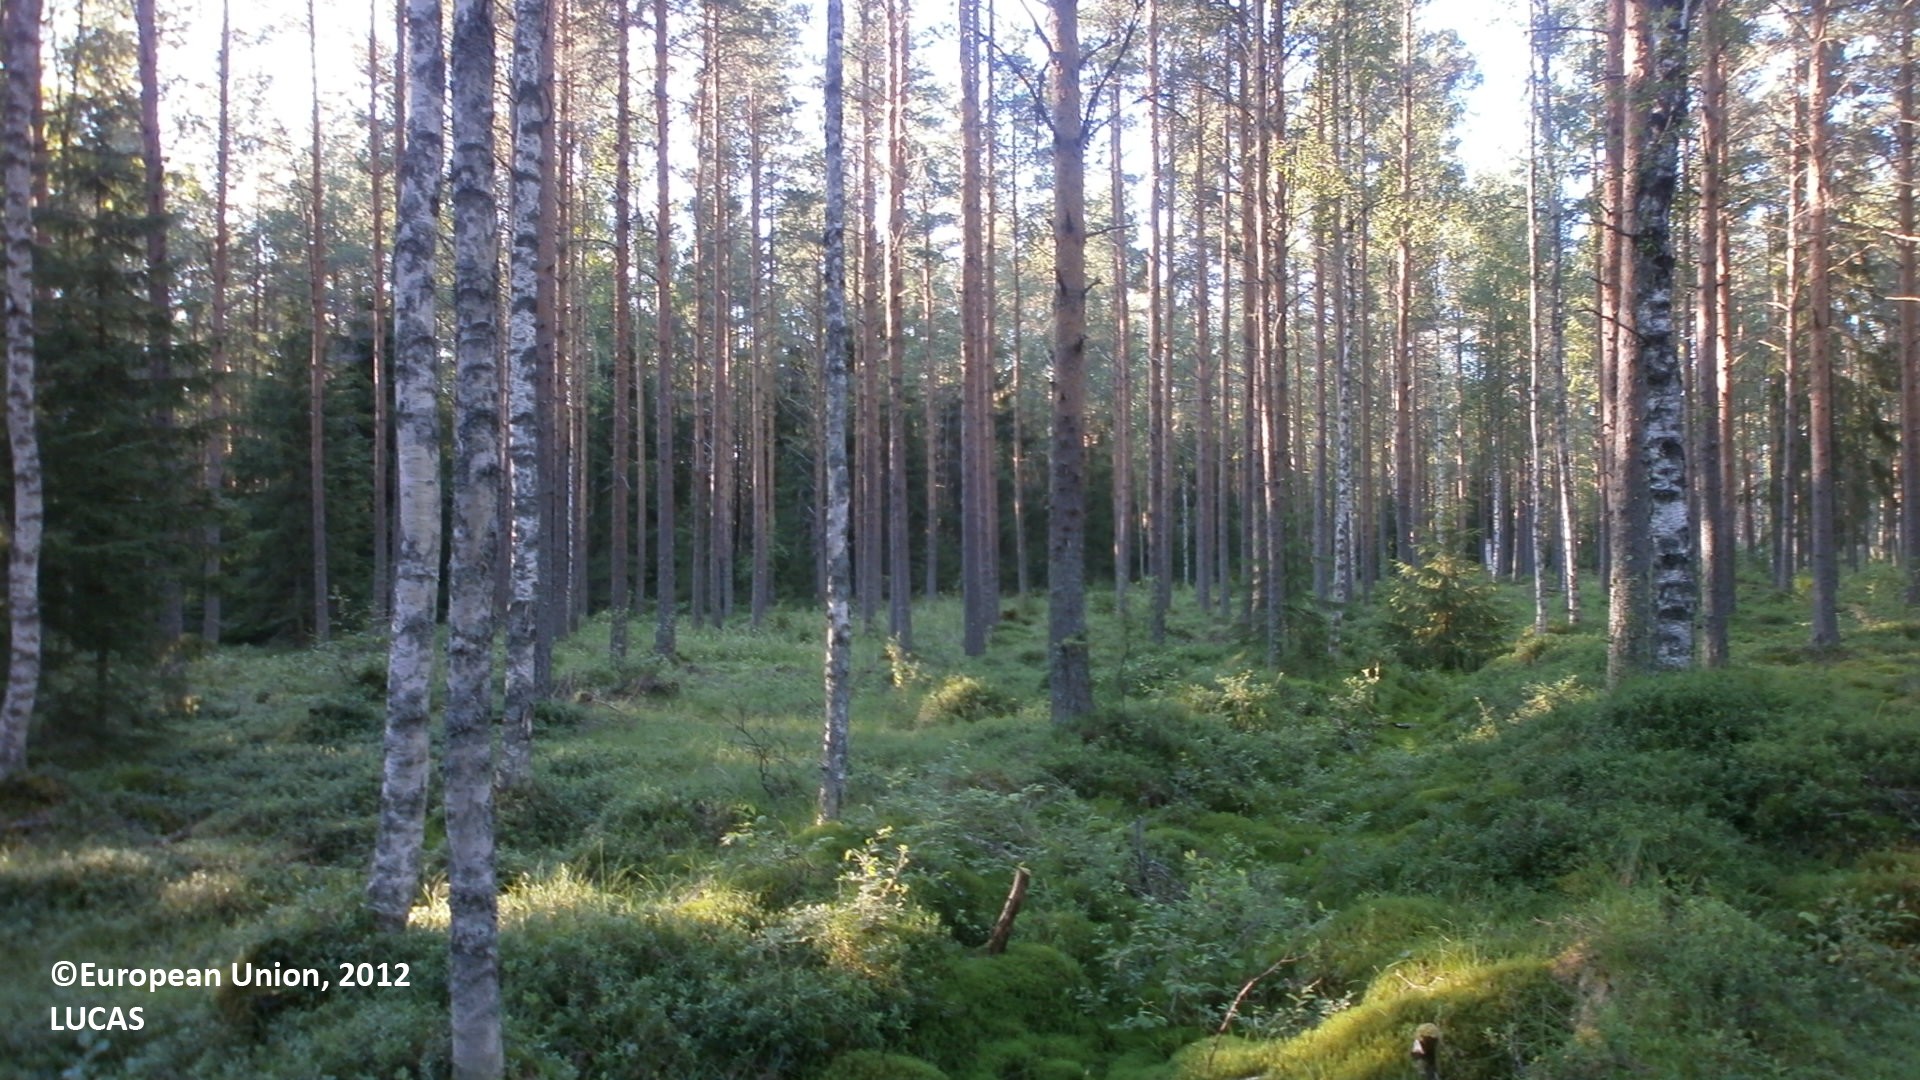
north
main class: Woodland
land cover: Pine dominated mixed woodland
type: boreal forest
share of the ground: 50 - 75 %
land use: Forestry
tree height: > 5 m
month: July
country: FI
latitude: 64.0484
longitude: 24.0129
